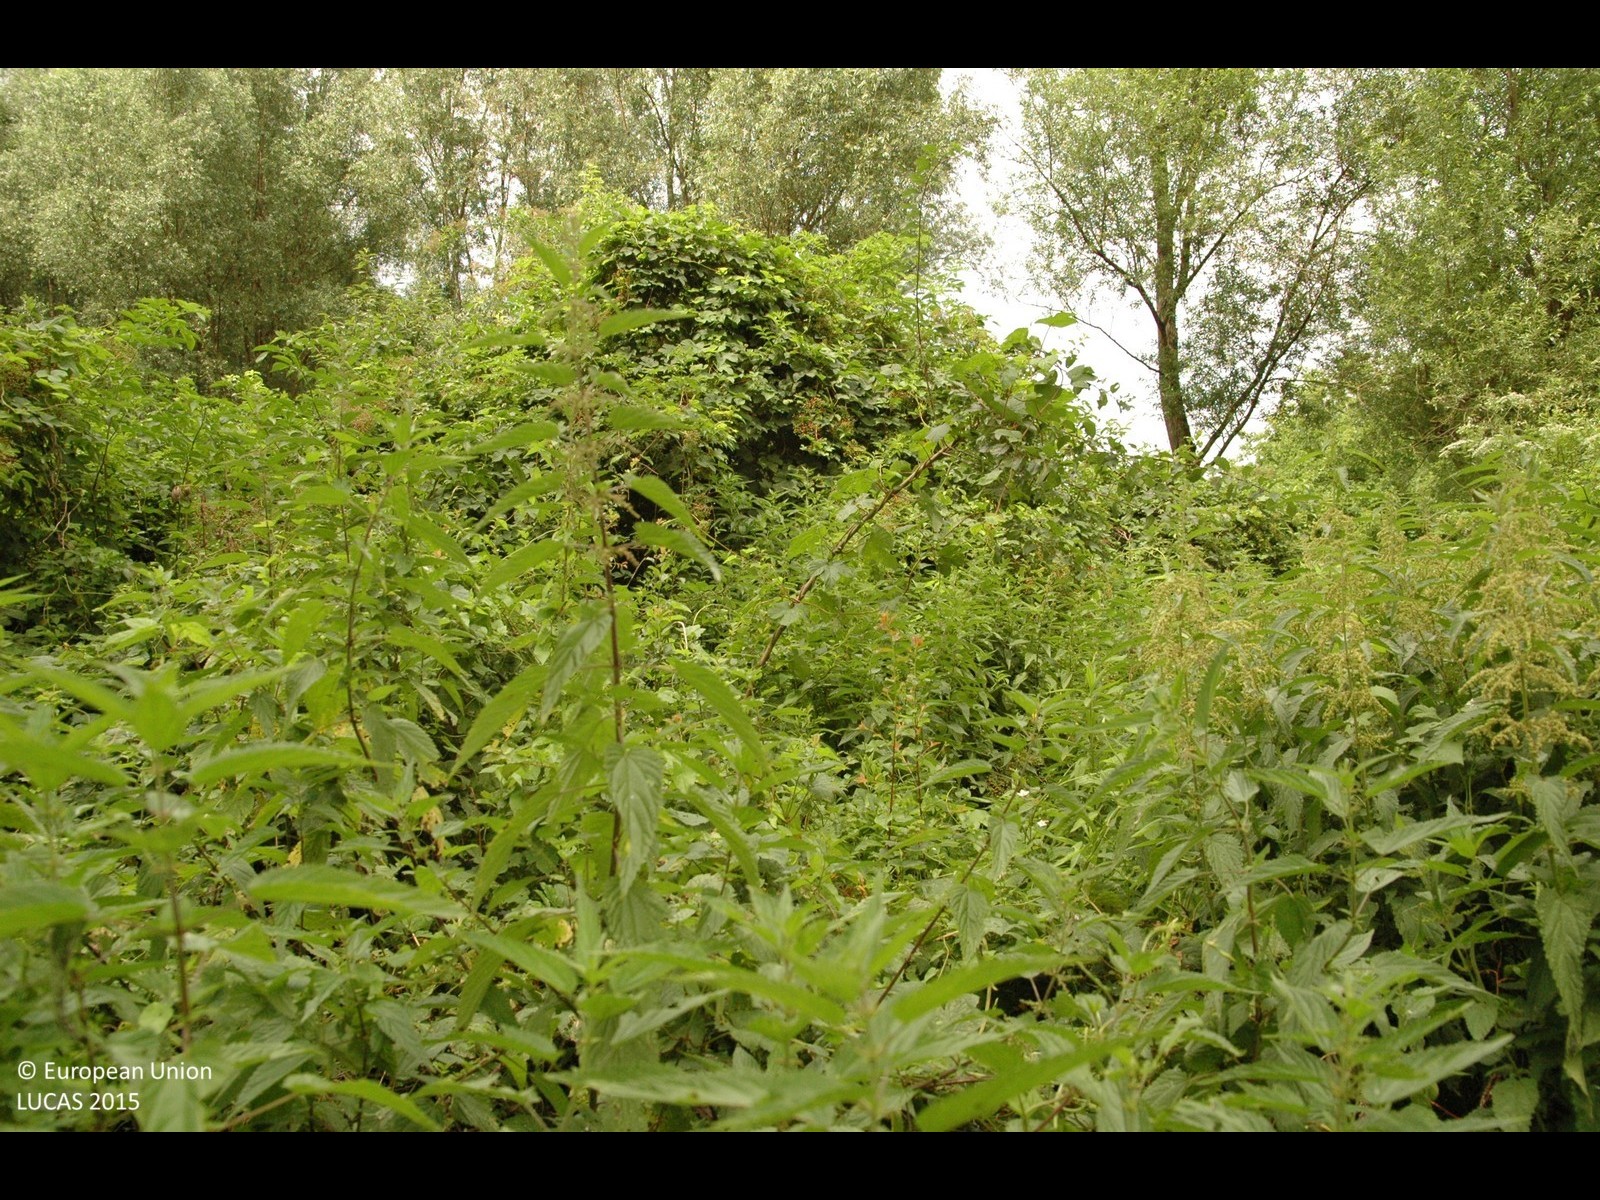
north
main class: Woodland
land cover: Broadleaved woodland
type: floodplain forest
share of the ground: > 75 %
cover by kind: broadleaved forest trees 90 %, shrubs 10 %
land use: Forestry
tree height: > 5 m
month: June
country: HR
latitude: 46.3819
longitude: 16.3063
